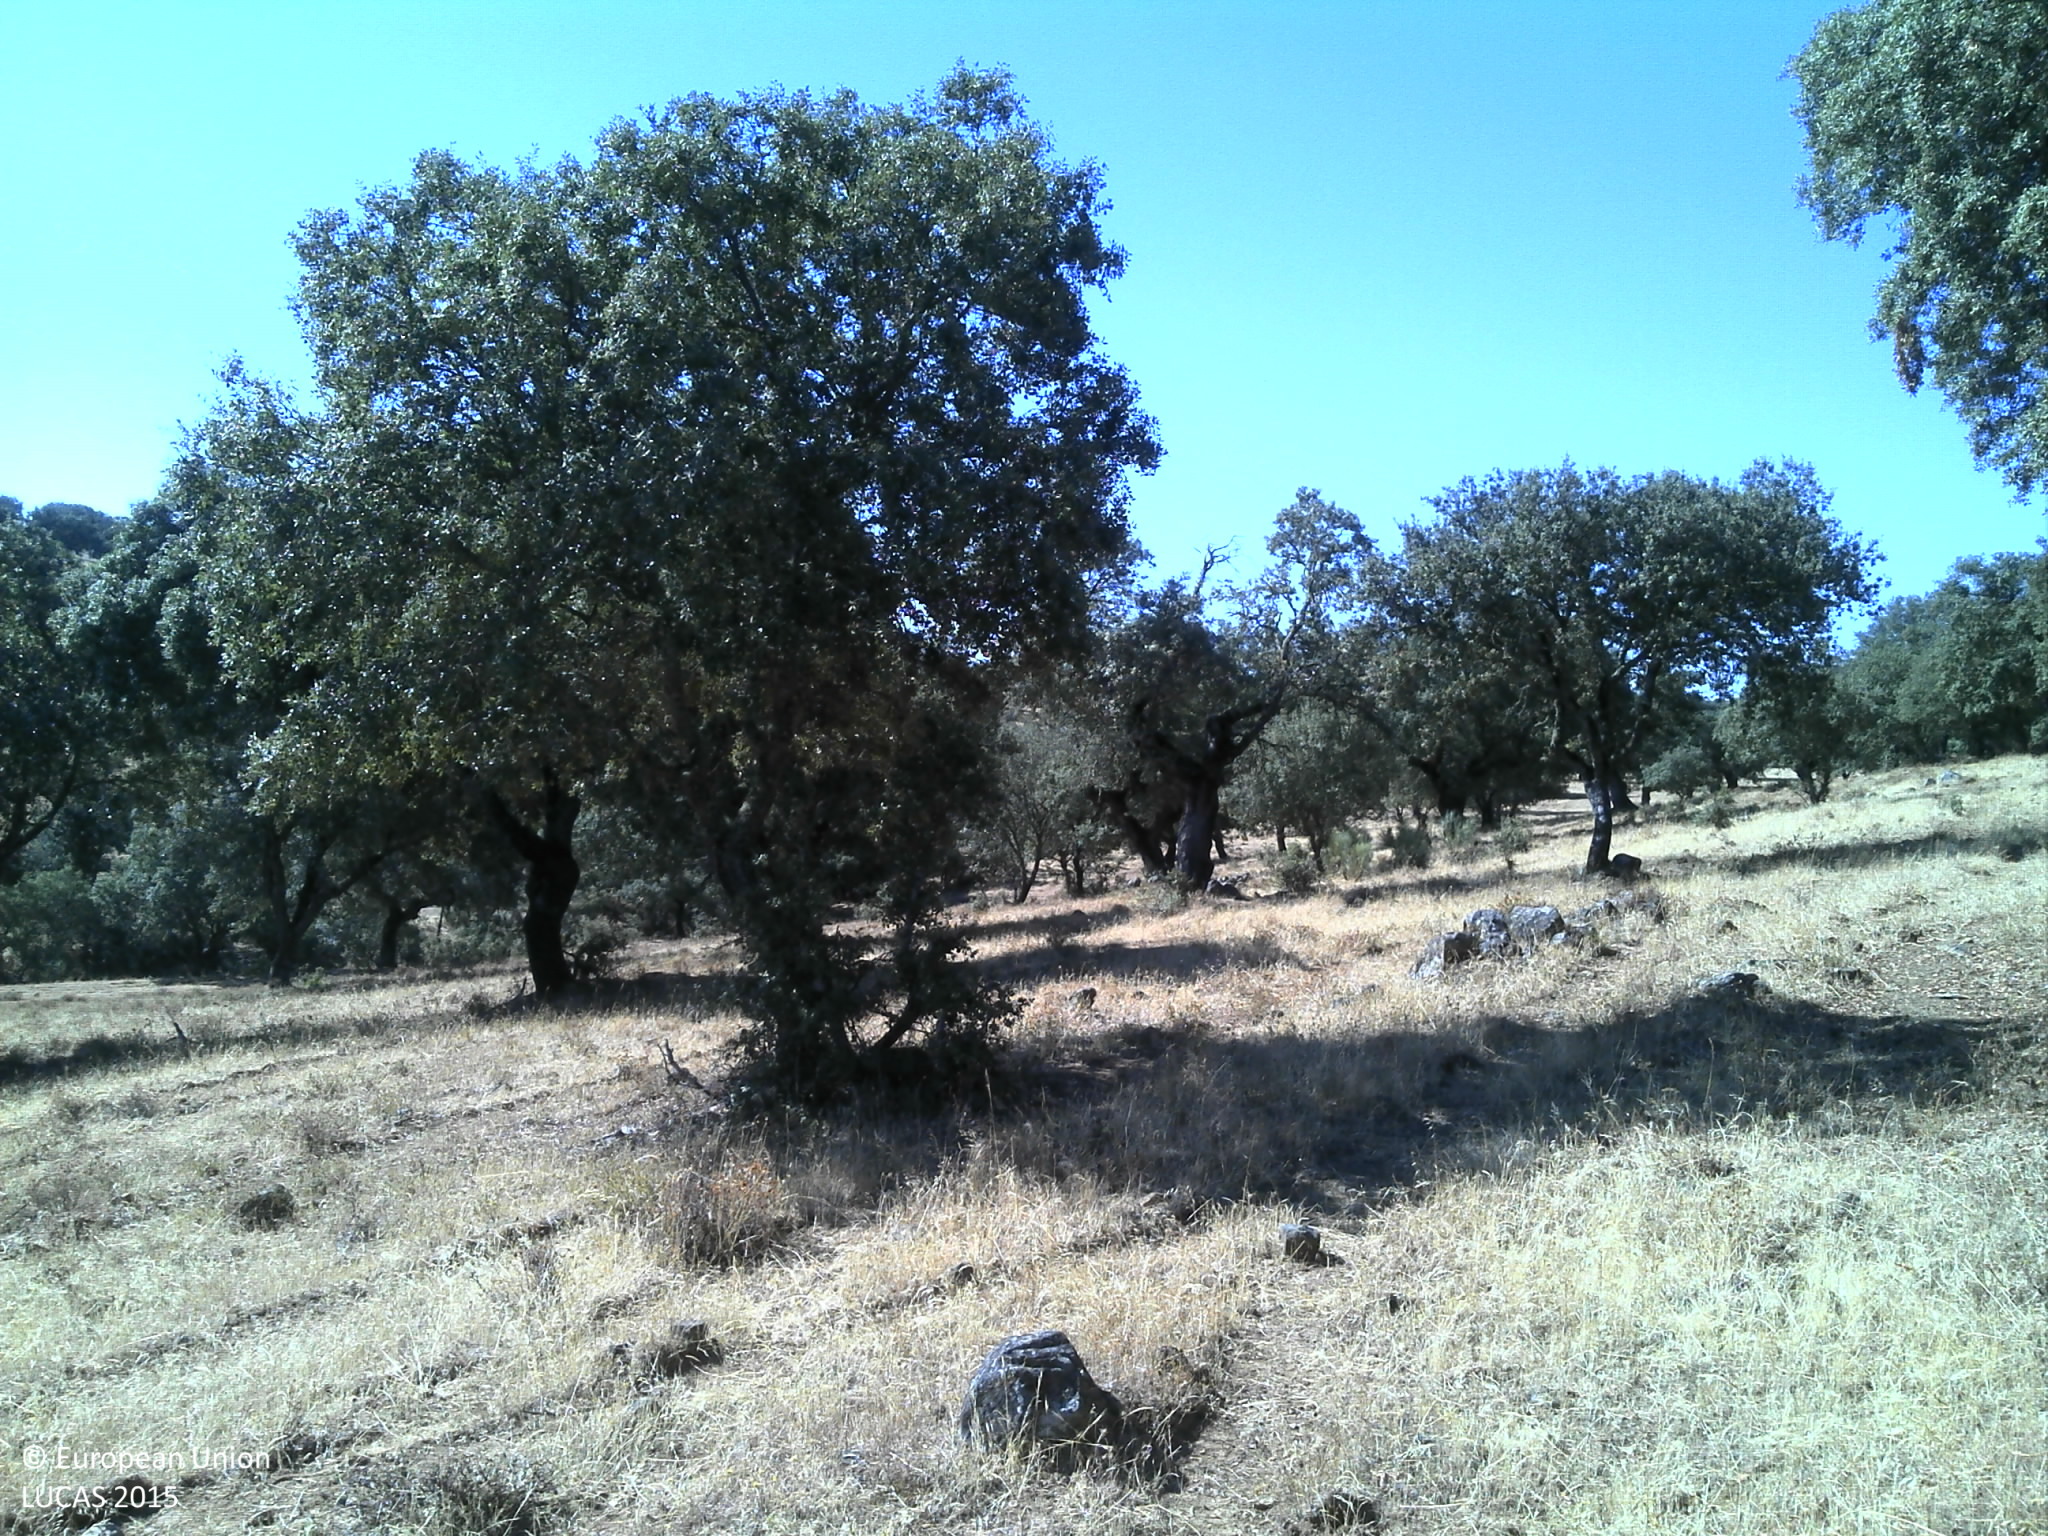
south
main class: Woodland
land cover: Broadleaved woodland
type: broadleaved evergreen forest
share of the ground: 10 - 25 %
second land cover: Grassland without tree/shrub cover
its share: 10 - 25 %
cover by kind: unconsolidated bare surface 65 %, broadleaved forest trees 15 %, herbaceous plants 15 %, consolidated bare surface 5 %
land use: Forestry
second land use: Agriculture (excluding fallow land and kitchen gardens)
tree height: > 5 m
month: July
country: PT
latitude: 39.0846
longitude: -7.1051
